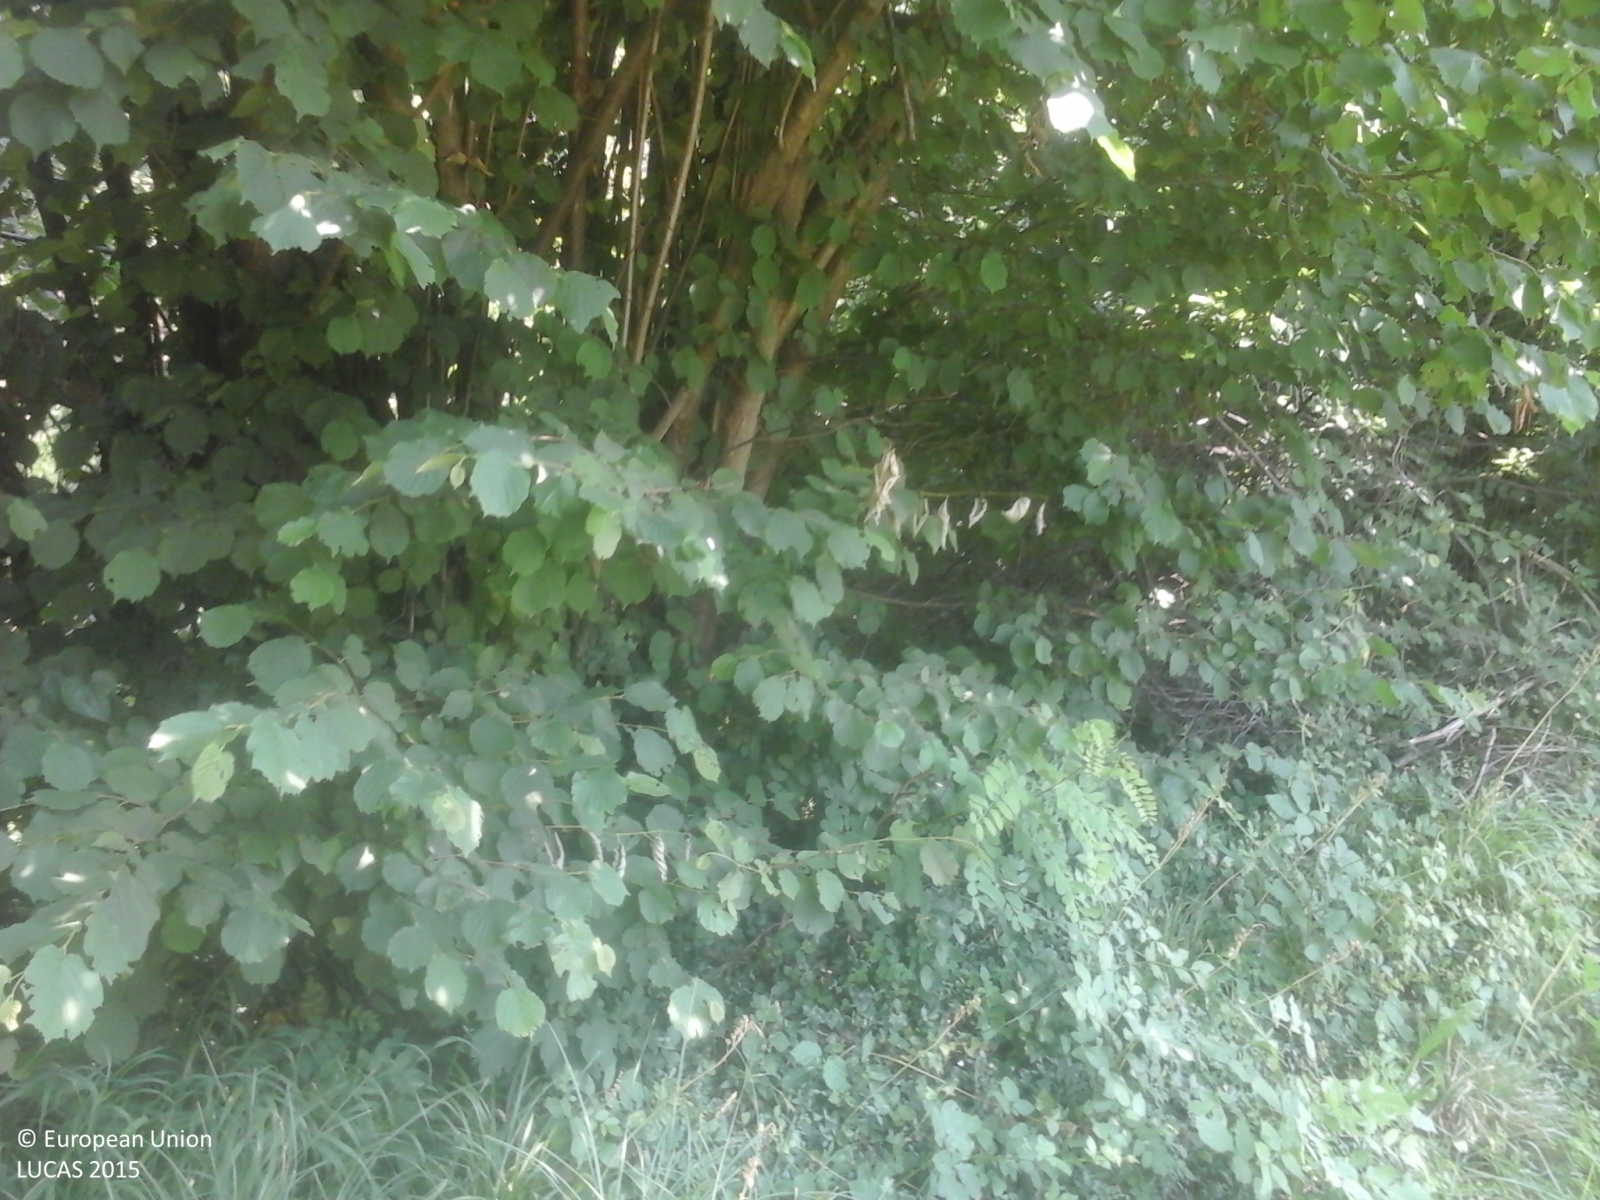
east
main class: Woodland
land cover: Broadleaved woodland
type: thermophilous deciduous forest
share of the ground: > 75 %
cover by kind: broadleaved forest trees 95 %, shrubs 5 %
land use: Forestry
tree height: > 5 m
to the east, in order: Broadleaved woodland; Inland fresh running water; Broadleaved woodland
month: July
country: IT
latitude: 45.8089
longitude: 9.3704
